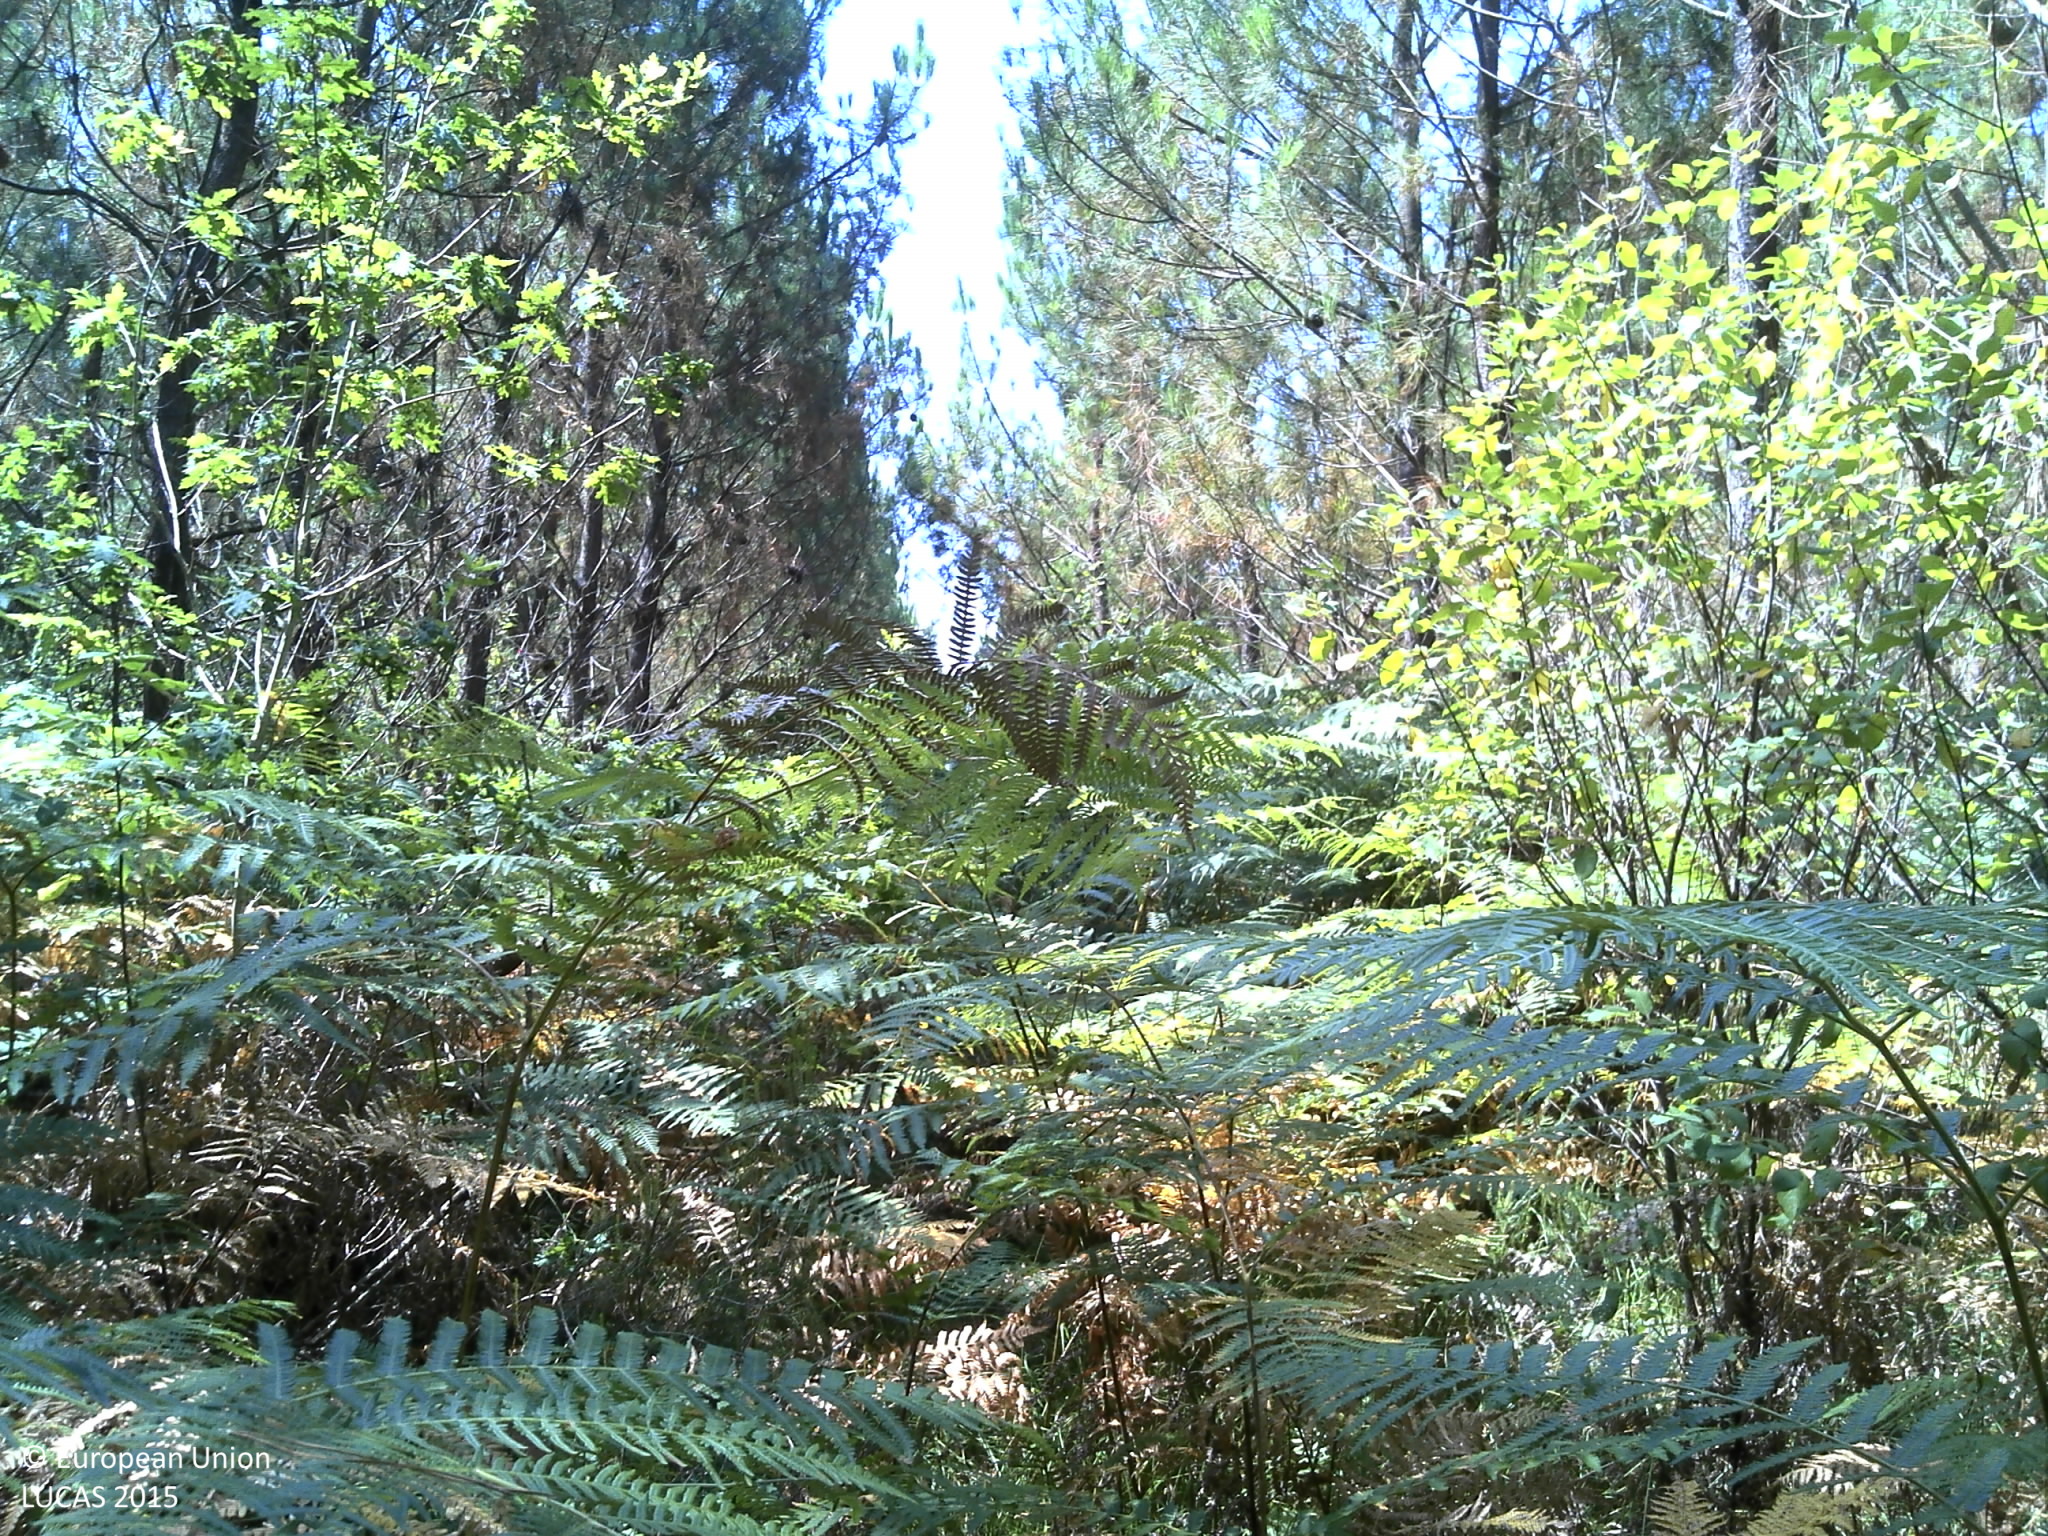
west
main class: Woodland
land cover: Pine dominated coniferous woodland
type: coniferous forest of the mediterranean region
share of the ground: > 75 %
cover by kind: coniferous forest trees 60 %, shrubs 30 %, herbaceous plants 5 %, lichens and mosses 5 %
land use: Forestry
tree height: > 5 m
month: August
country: FR
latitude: 44.9830
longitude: -0.9935
